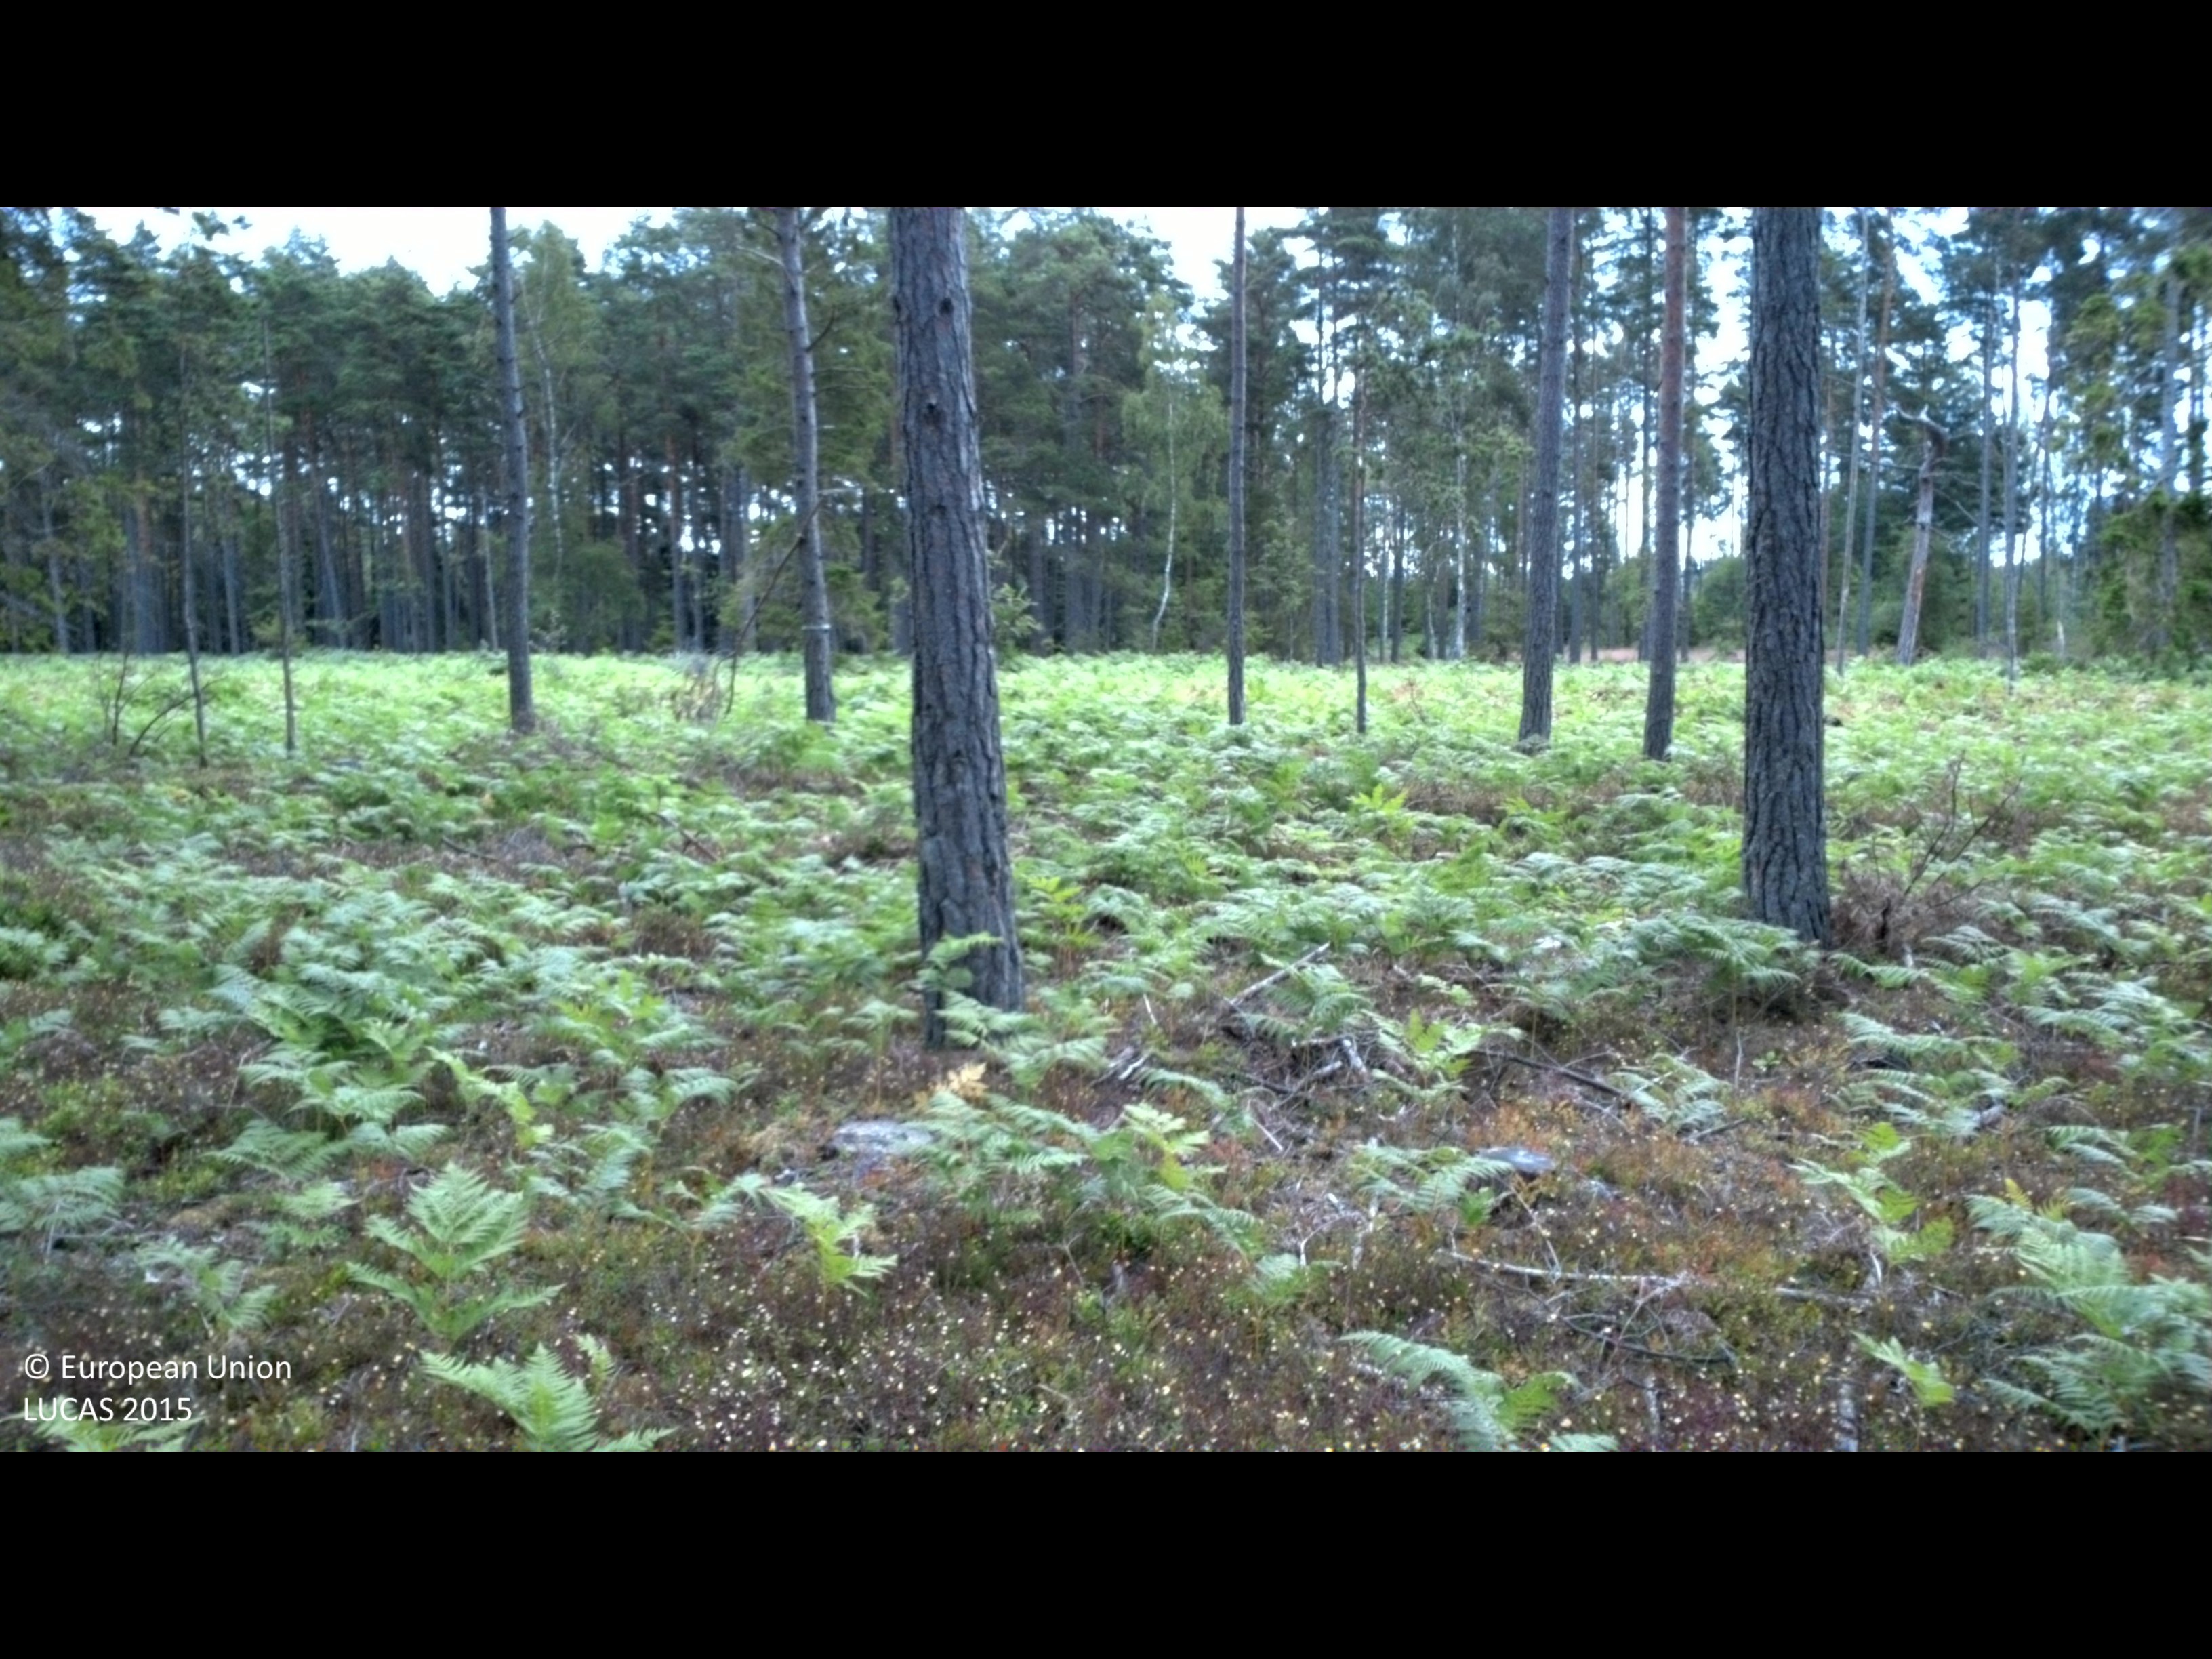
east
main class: Woodland
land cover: Pine dominated coniferous woodland
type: boreal forest
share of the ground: 50 - 75 %
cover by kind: coniferous forest trees 60 %, shrubs 35 %, herbaceous plants 5 %
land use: Forestry
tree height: > 5 m
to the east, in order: Pine dominated coniferous woodland; Shrubland without tree cover; Tracks; Dry stone walls; Pine dominated coniferous woodland; Groves; Dry stone walls; Grassland without tree/shrub cover
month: July
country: SE
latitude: 57.2239
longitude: 17.0076
